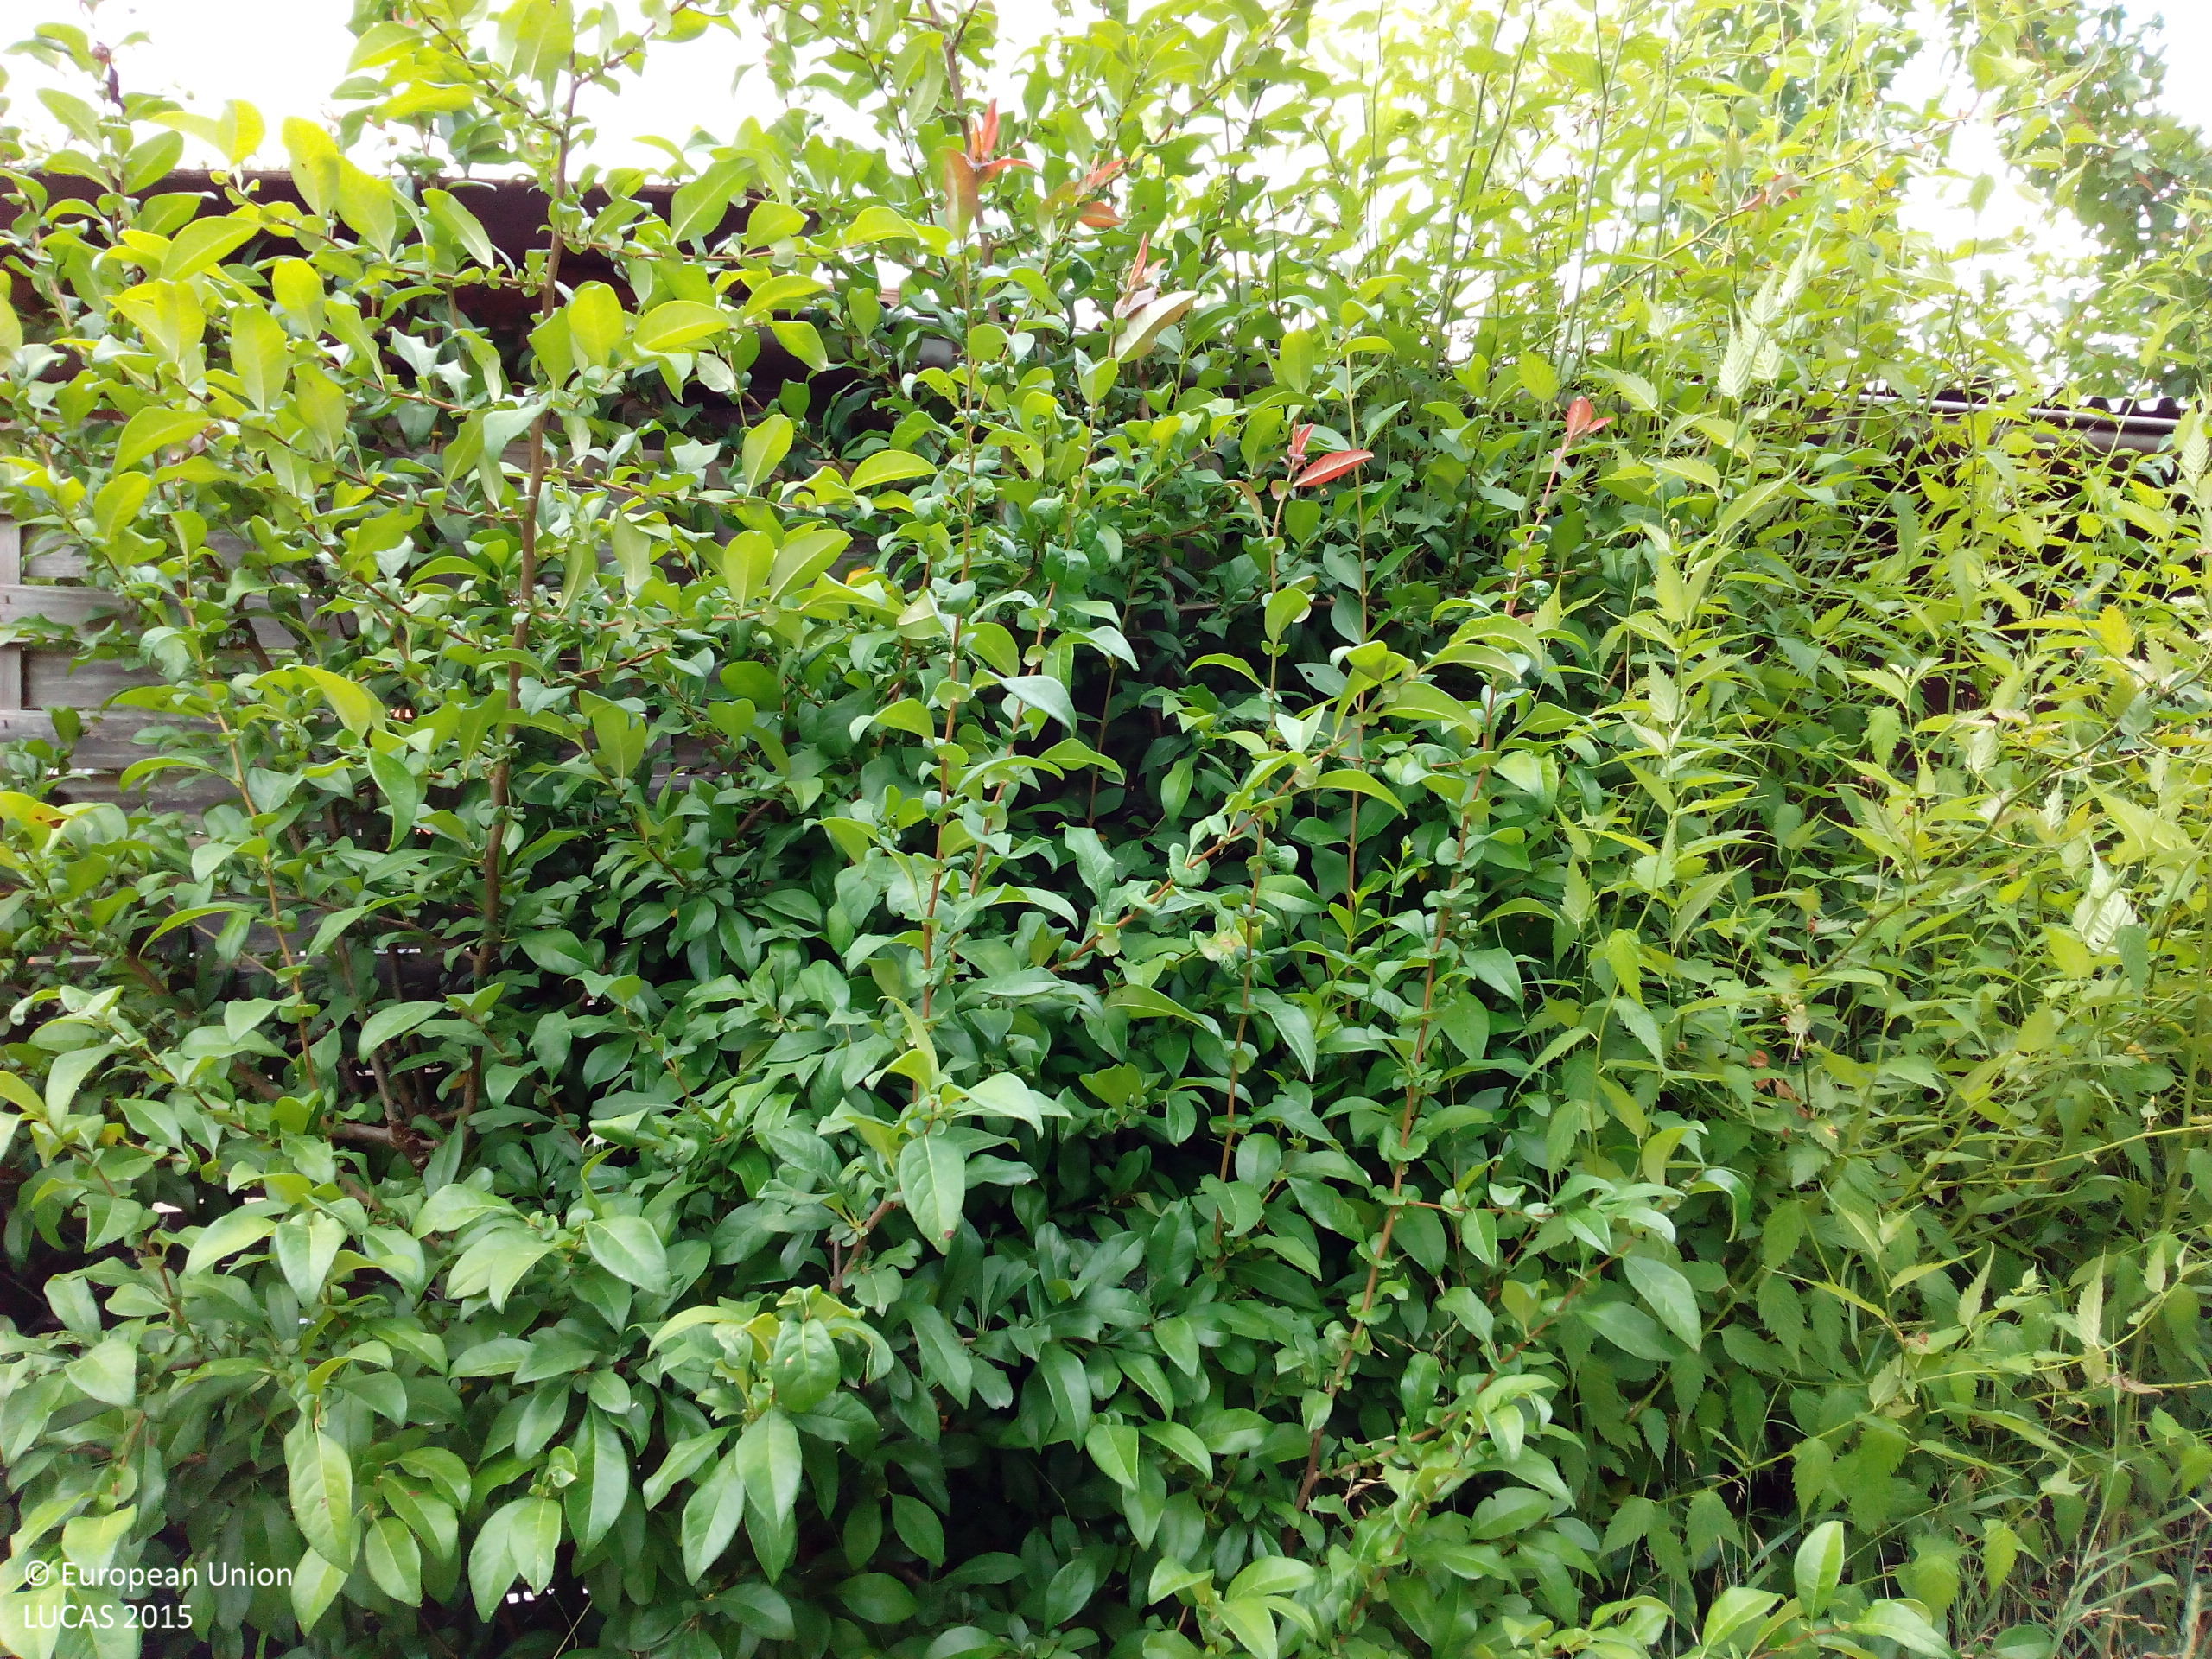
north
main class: Grassland
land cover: Grassland without tree/shrub cover
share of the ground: > 75 %
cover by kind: herbaceous plants 85 %, unconsolidated bare surface 15 %
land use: Kitchen garden
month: July
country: DE
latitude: 47.6414
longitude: 7.6987
